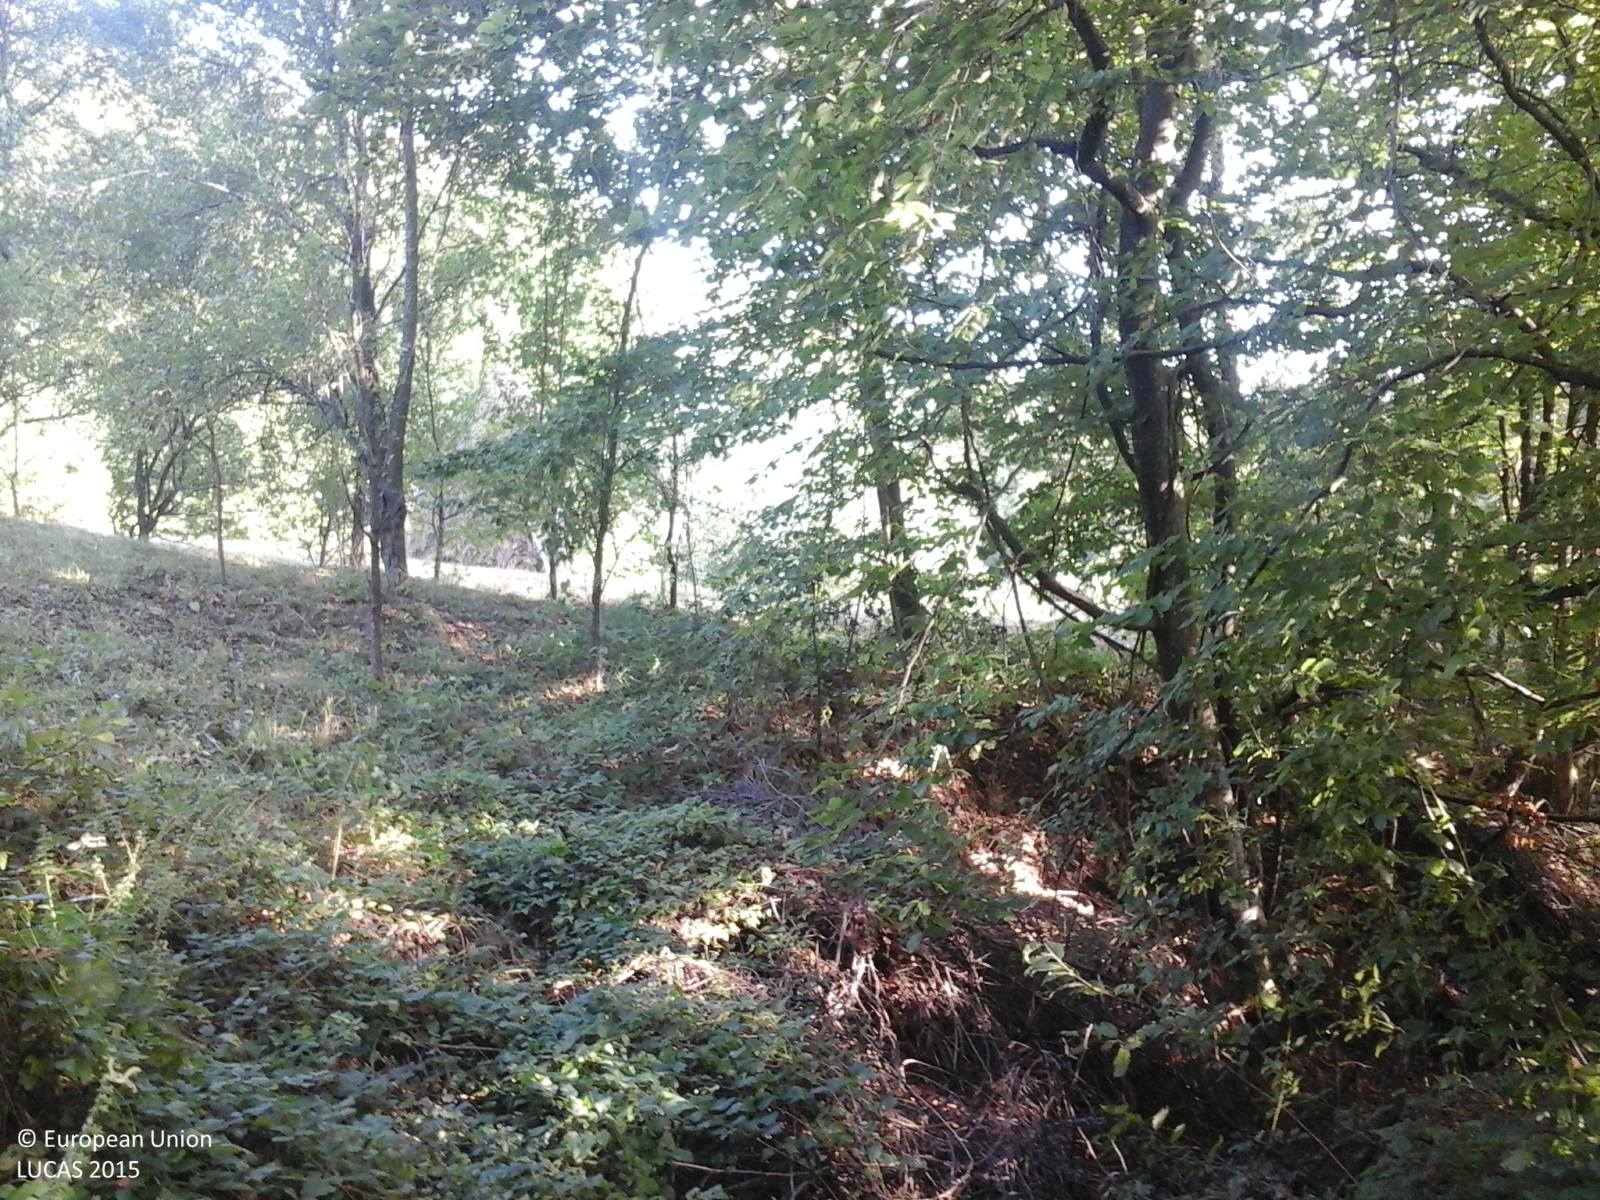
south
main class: Woodland
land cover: Broadleaved woodland
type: mesophytic deciduous forest
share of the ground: > 75 %
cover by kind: broadleaved forest trees 100 %
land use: Forestry
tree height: > 5 m
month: September
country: RO
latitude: 47.2900
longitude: 23.8438
